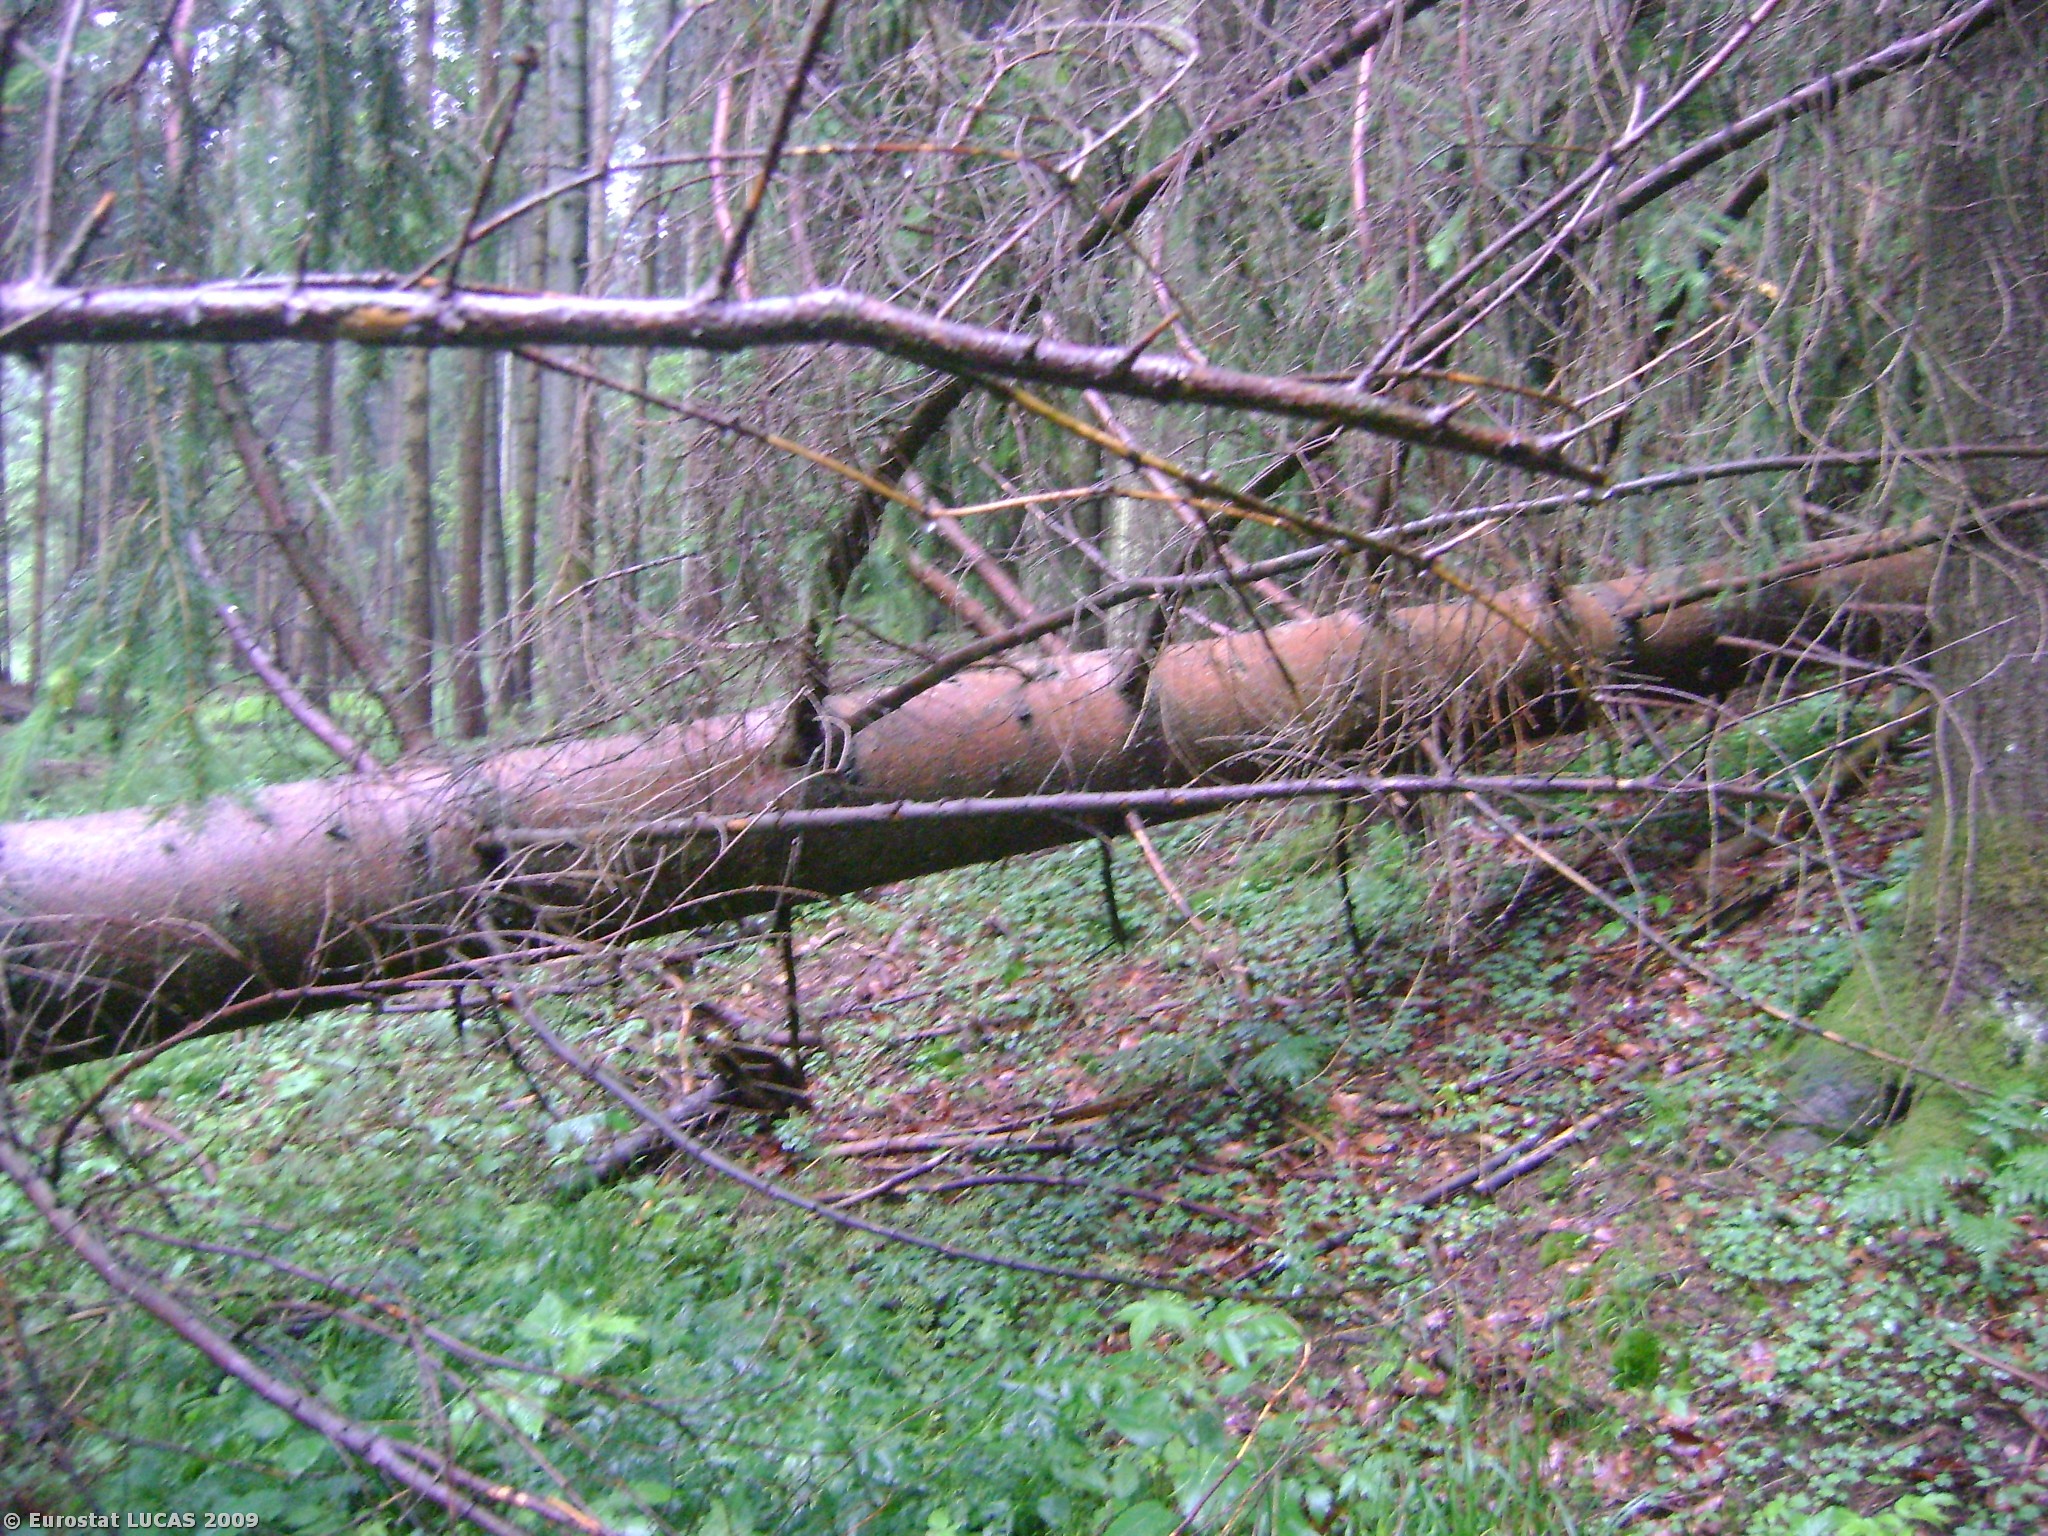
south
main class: Woodland
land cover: Coniferous woodland
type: hemiboreal forest and nemoral coniferous forest and mixed broadleaved-coniferous forest
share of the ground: > 75 %
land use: Forestry
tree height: > 5 m
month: June
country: AT
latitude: 47.8696
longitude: 13.2474
